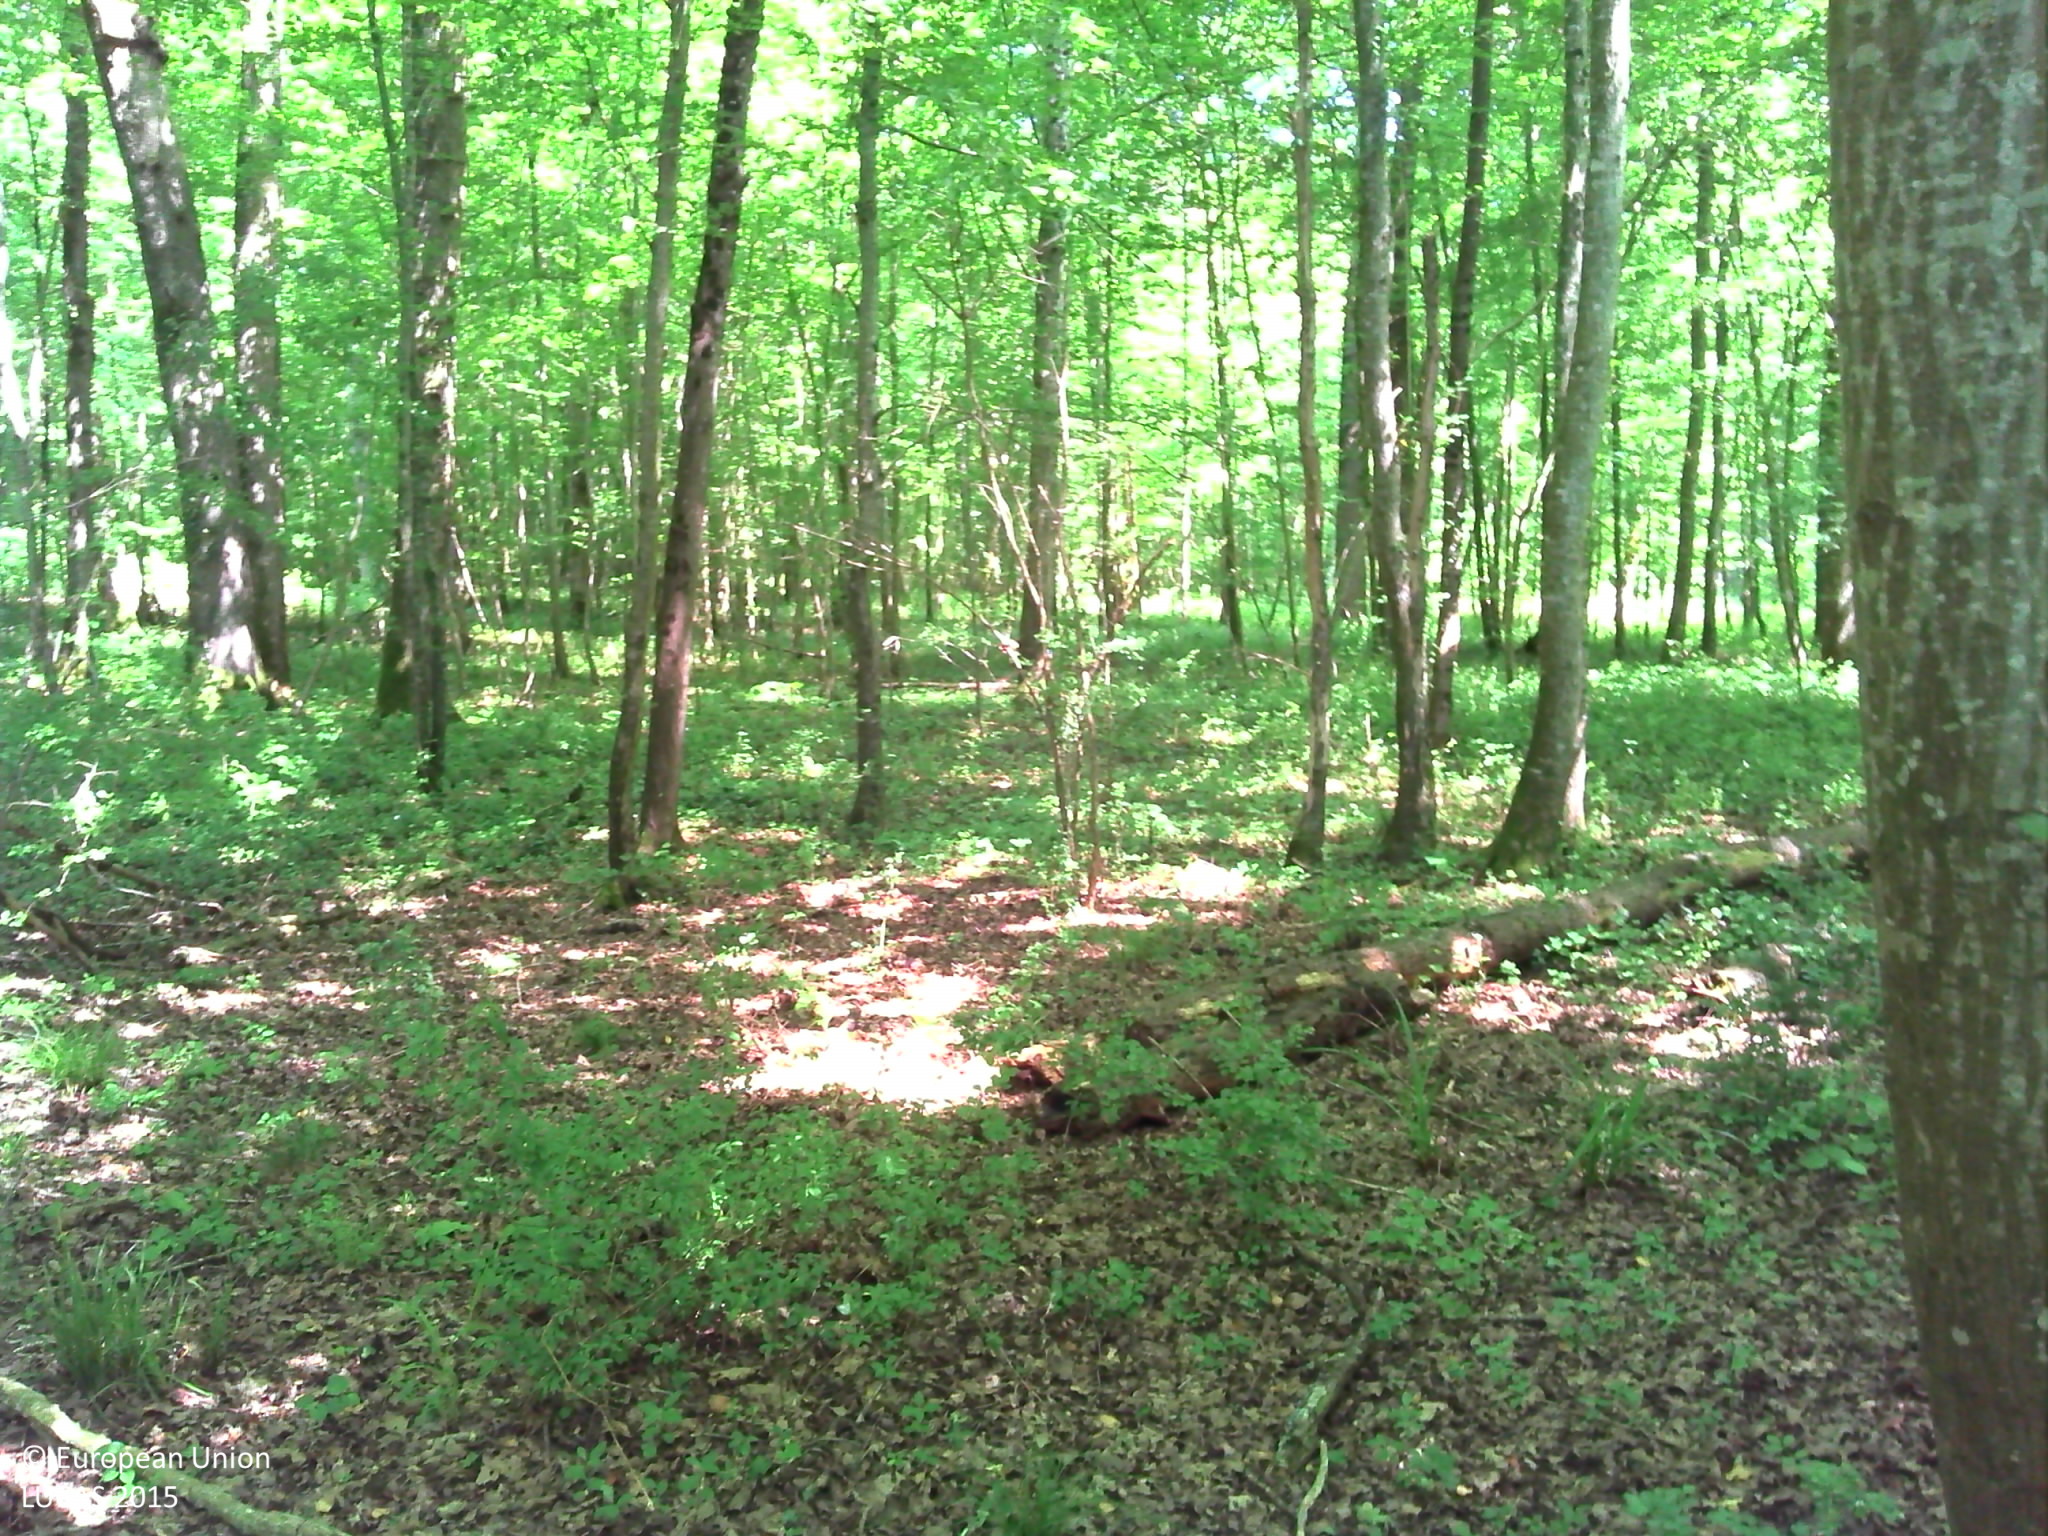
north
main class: Woodland
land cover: Broadleaved woodland
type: mesophytic deciduous forest
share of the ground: > 75 %
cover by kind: broadleaved forest trees 85 %, herbaceous plants 10 %, coniferous forest trees 5 %
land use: Forestry
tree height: > 5 m
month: June
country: FR
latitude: 48.4302
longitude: 4.9031
